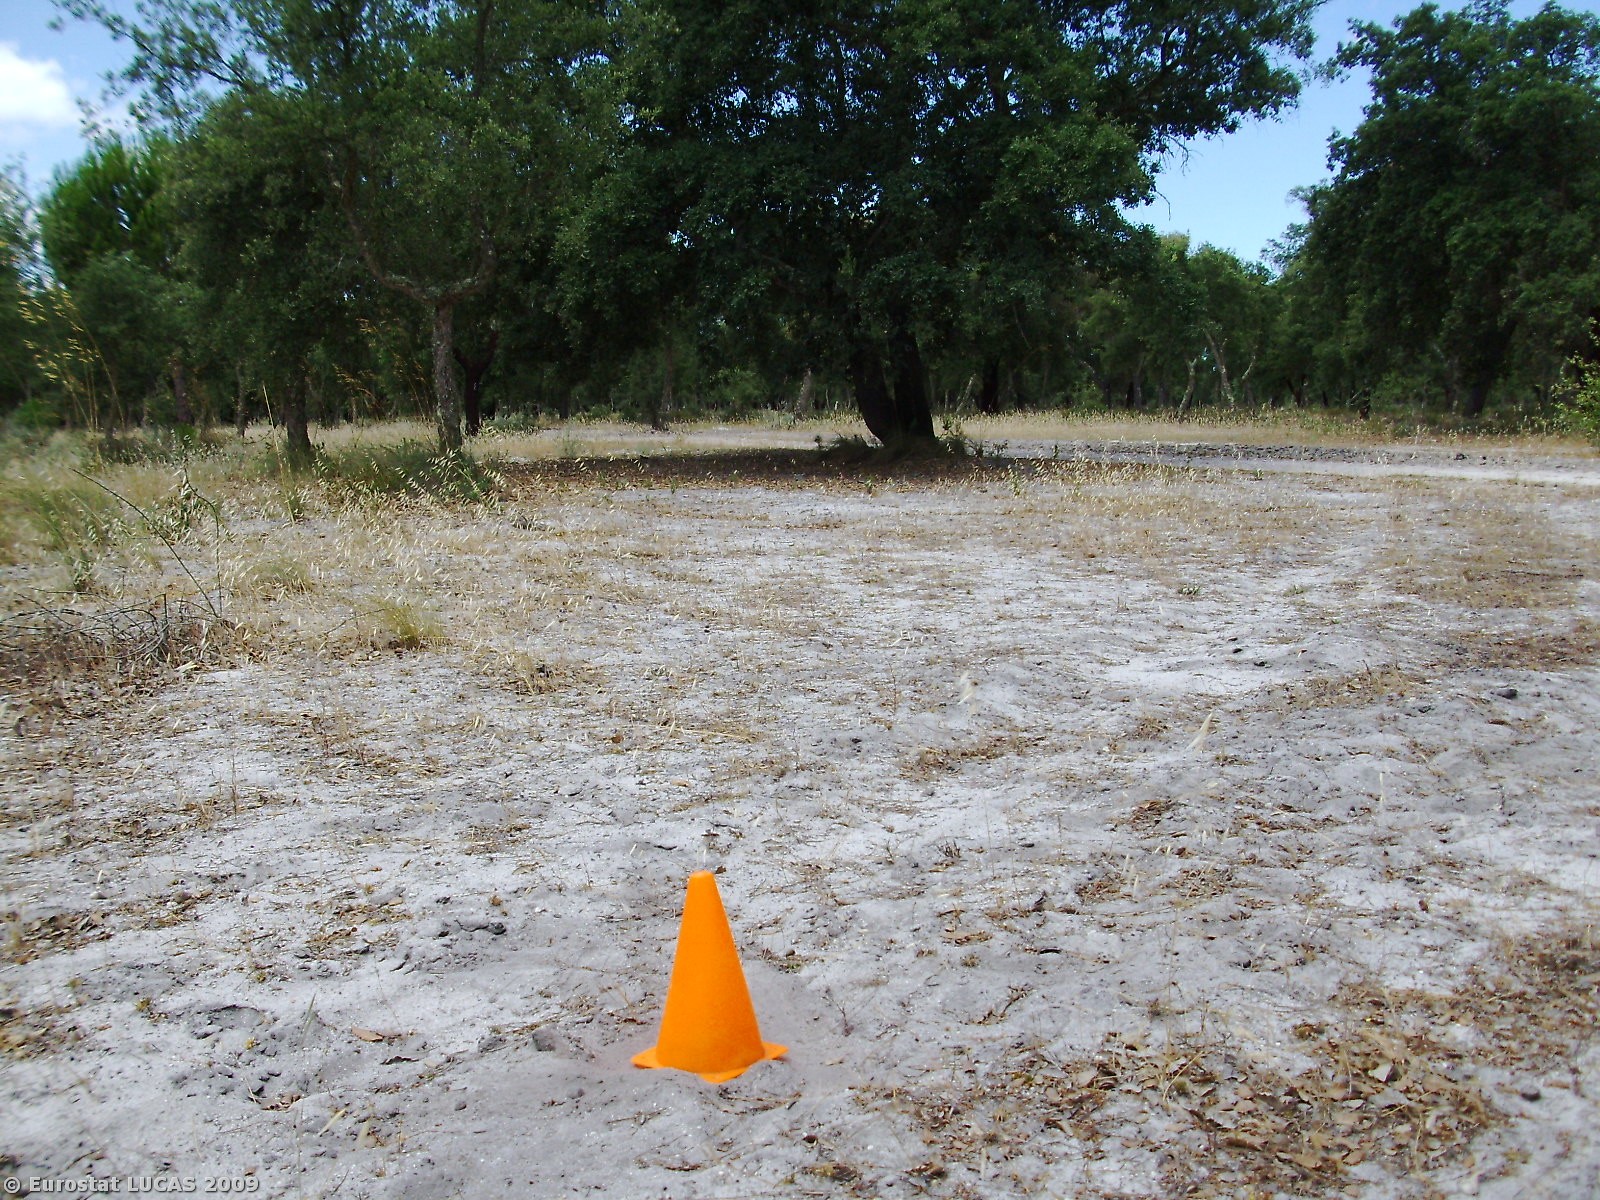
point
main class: Woodland
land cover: Broadleaved woodland
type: broadleaved evergreen forest
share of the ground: 25 - 50 %
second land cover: Spontaneously vegetated surfaces
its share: 10 - 25 %
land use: Forestry
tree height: > 5 m
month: June
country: PT
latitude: 38.2538
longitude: -8.5741
